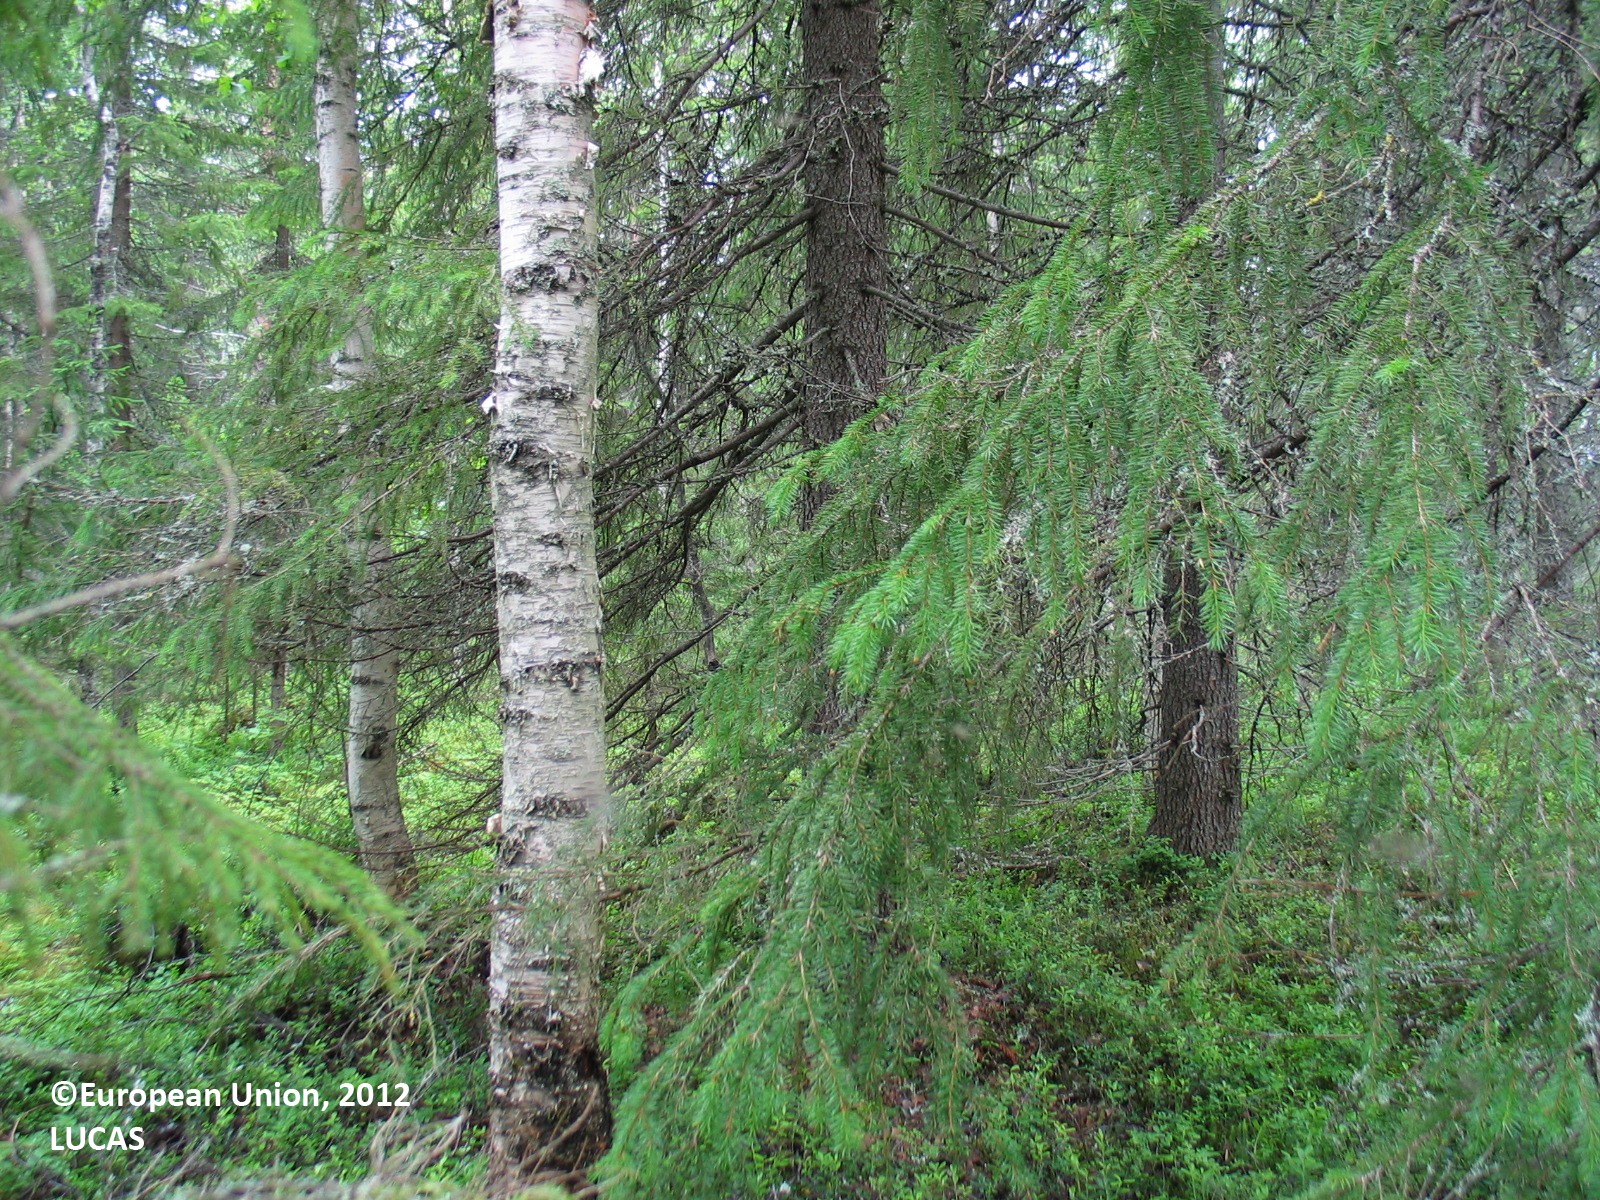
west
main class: Woodland
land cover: Spruce dominated coniferous woodland
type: boreal forest
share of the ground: 50 - 75 %
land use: Forestry
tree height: > 5 m
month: July
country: FI
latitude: 65.9839
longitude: 25.0571
